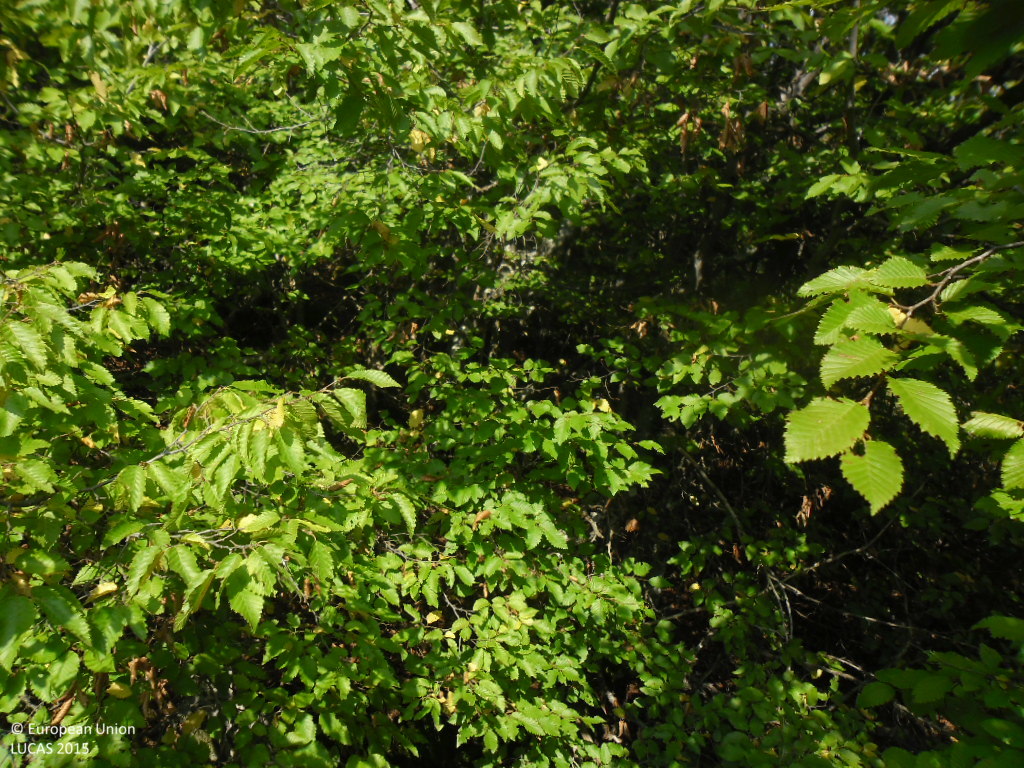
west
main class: Woodland
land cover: Broadleaved woodland
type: mesophytic deciduous forest
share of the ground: > 75 %
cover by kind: broadleaved forest trees 90 %, unconsolidated bare surface 10 %
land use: Forestry
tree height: < 5 m
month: September
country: BG
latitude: 41.9301
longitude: 22.9371
